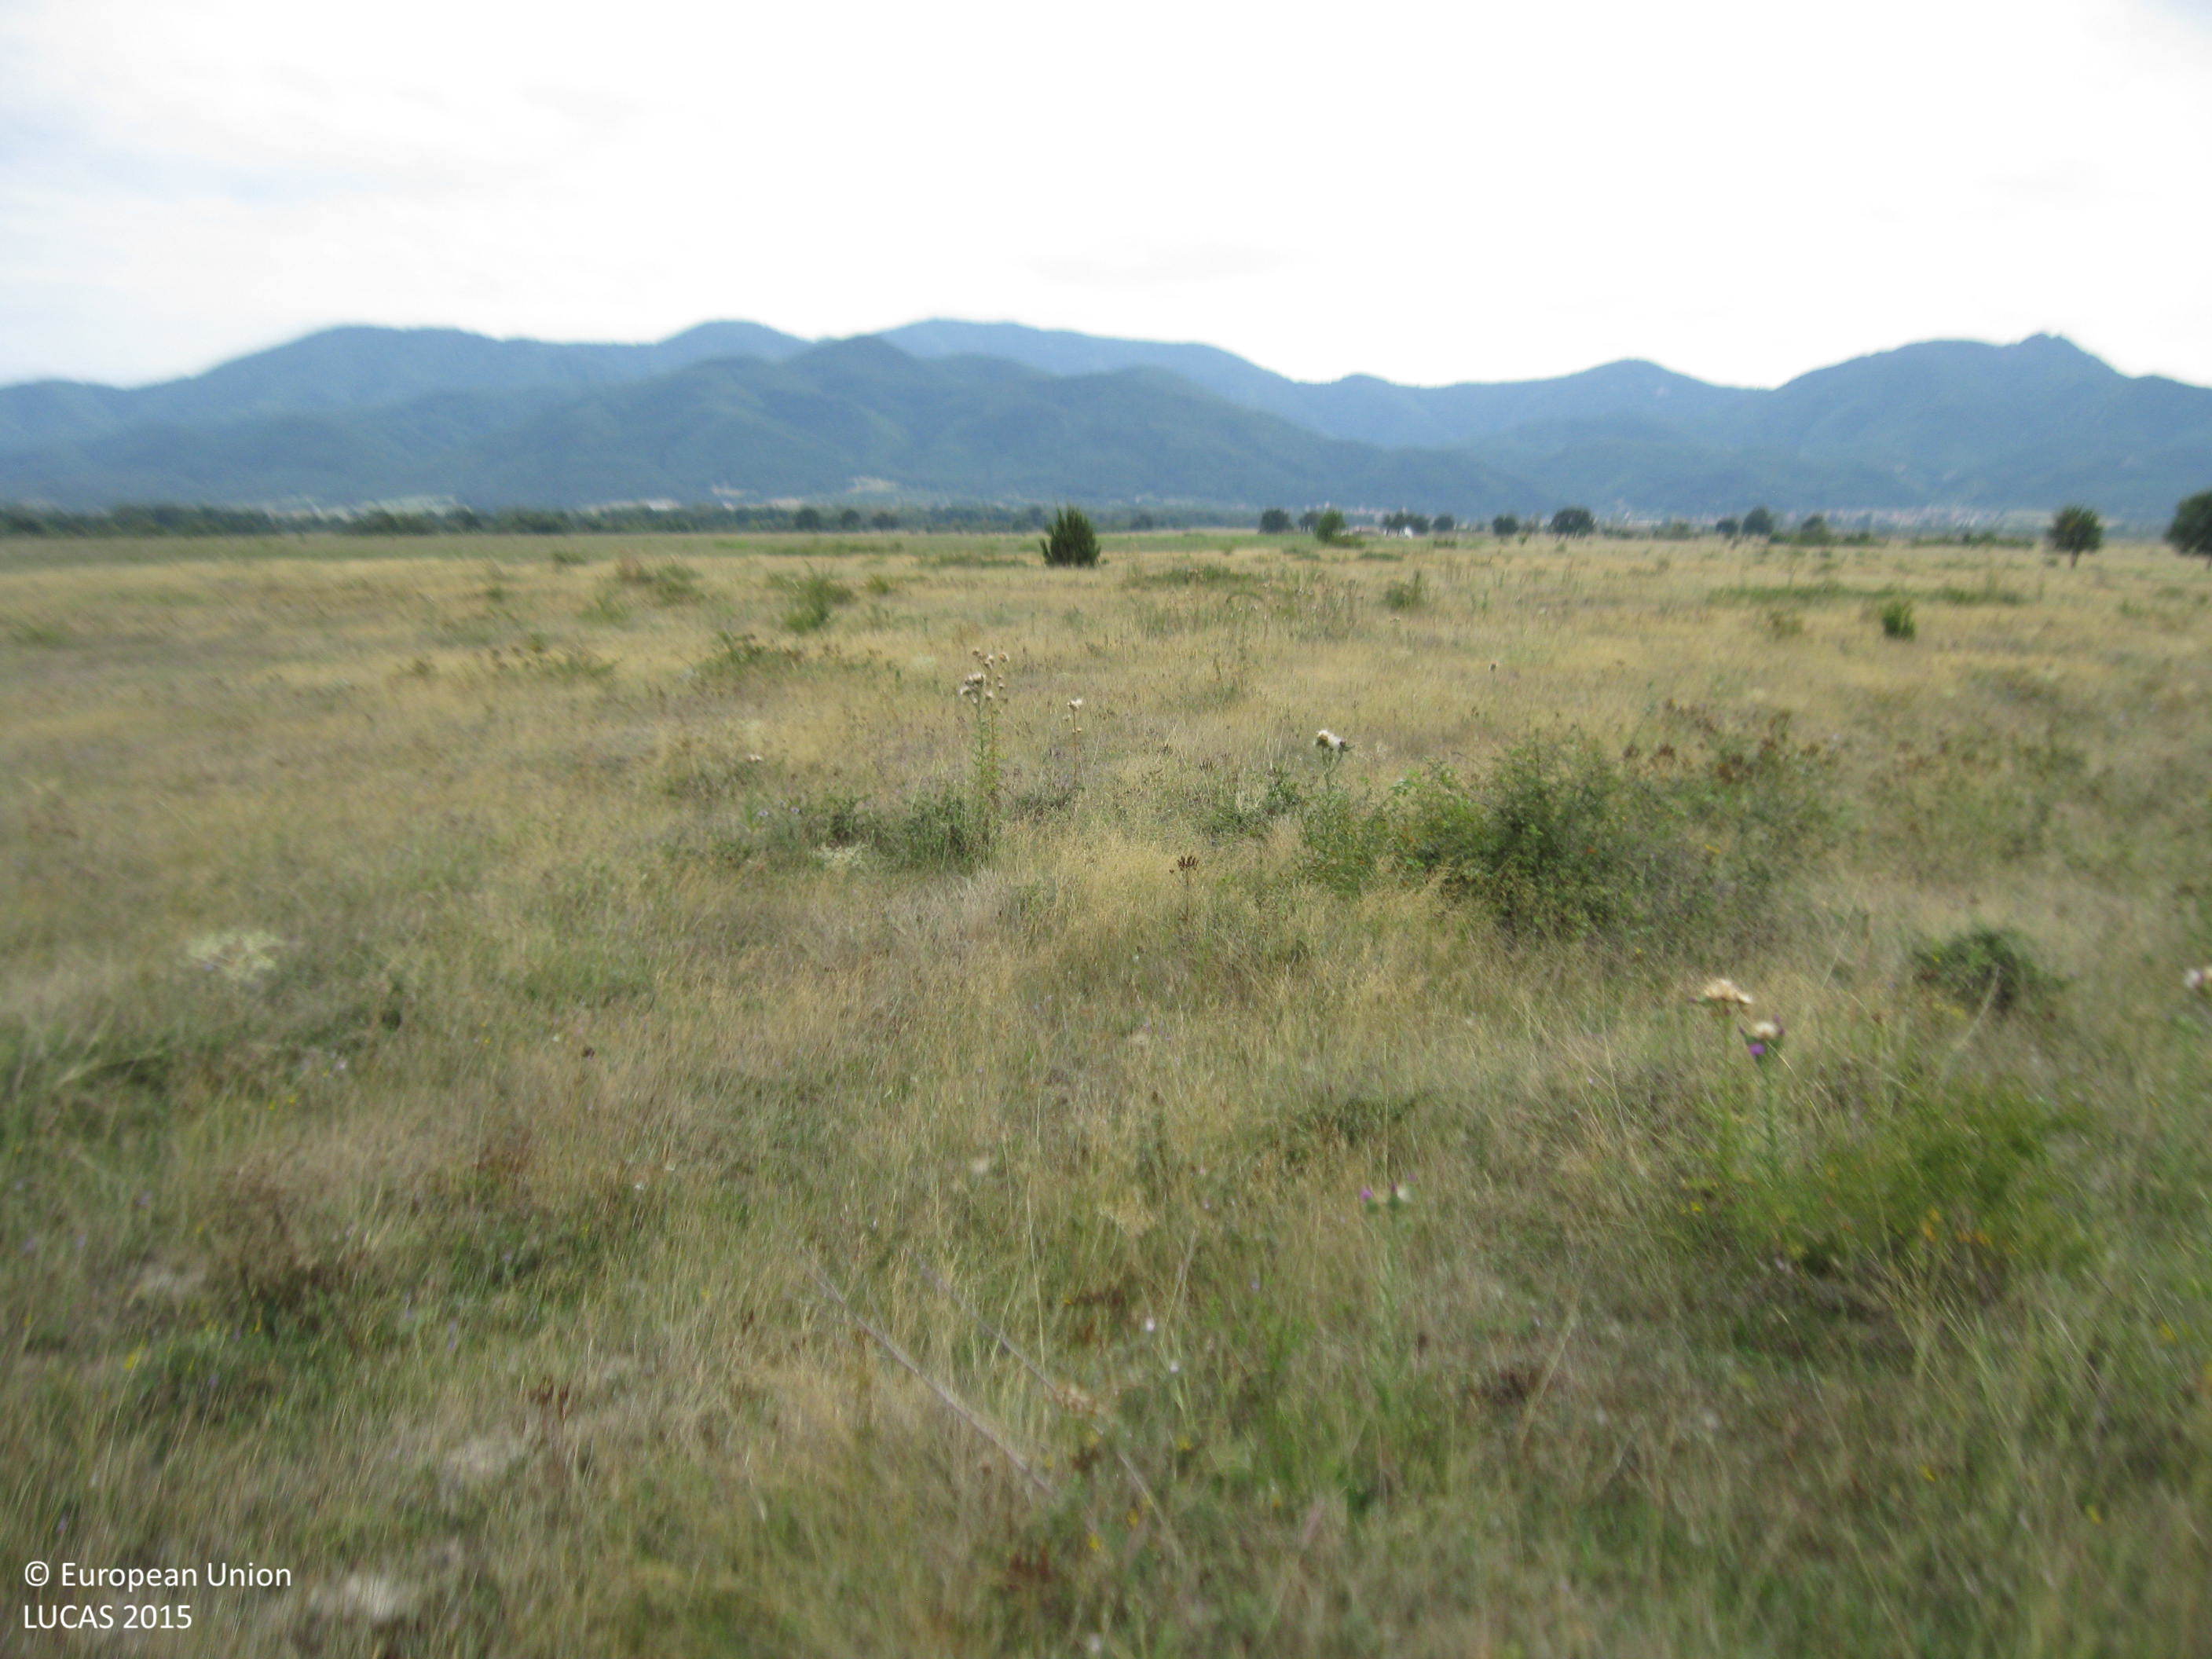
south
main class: Grassland
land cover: Grassland with sparse tree/shrub cover
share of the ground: > 75 %
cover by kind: herbaceous plants 90 %, broadleaved forest trees 5 %, shrubs 5 %
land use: Semi-natural and natural areas not in use
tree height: > 5 m
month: September
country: BG
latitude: 41.9478
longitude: 25.0242
